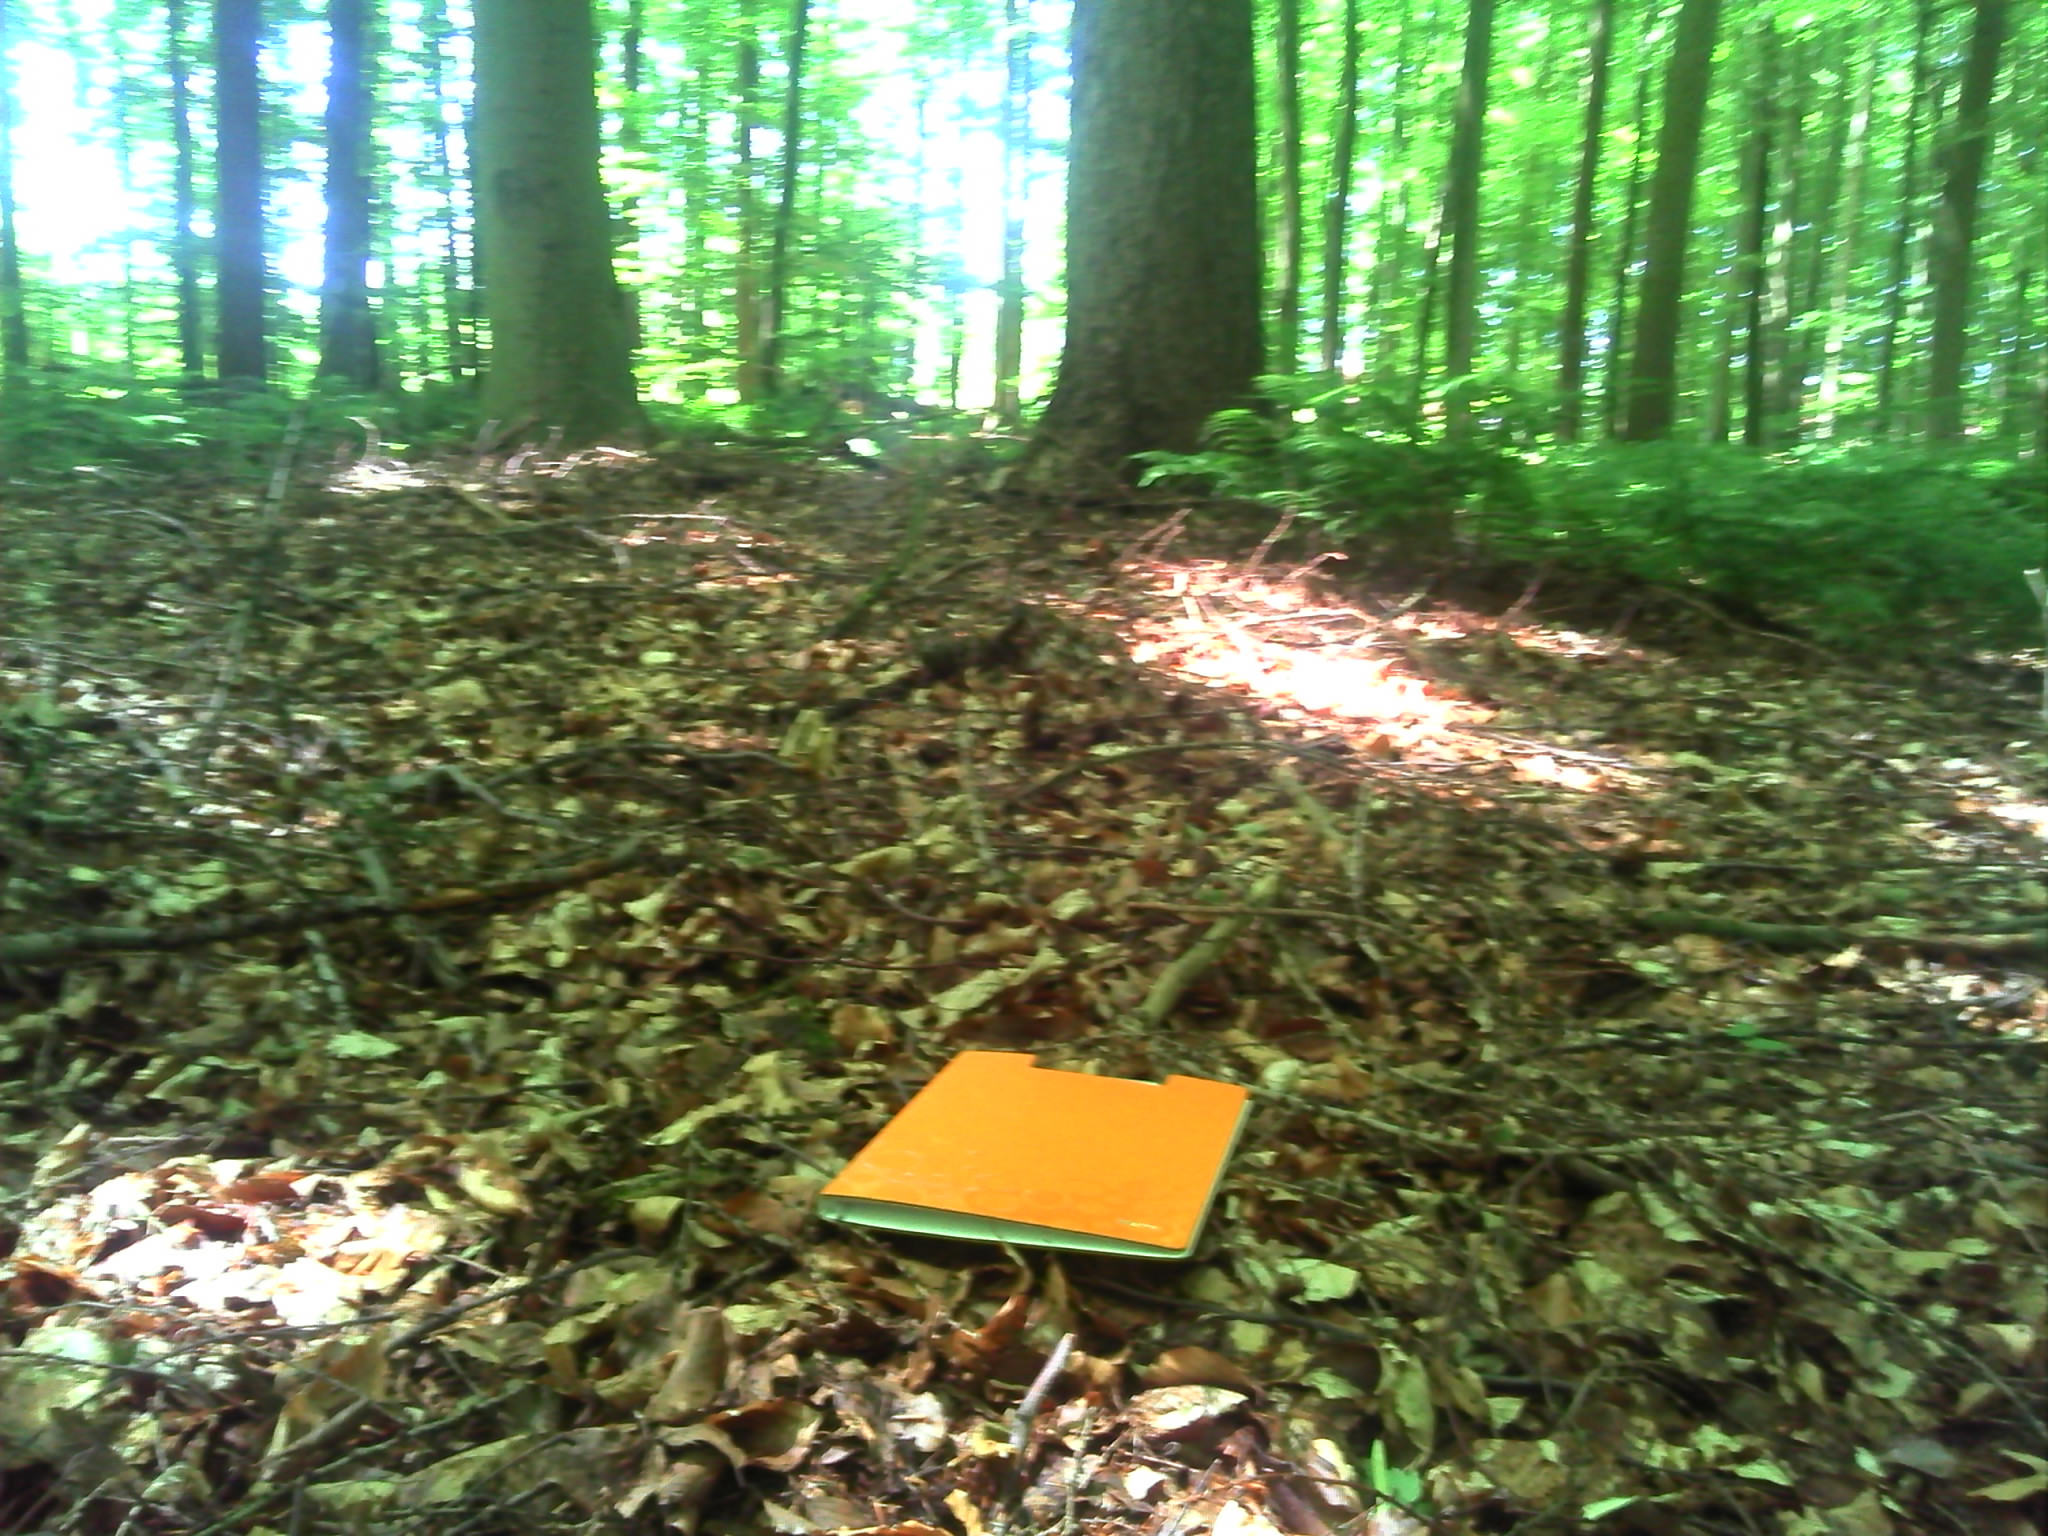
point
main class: Woodland
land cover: Broadleaved woodland
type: beech forest
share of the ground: > 75 %
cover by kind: broadleaved forest trees 80 %, shrubs 10 %, coniferous forest trees 5 %, herbaceous plants 5 %
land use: Forestry
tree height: > 5 m
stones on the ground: < 10 %
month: June
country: BE
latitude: 50.7495
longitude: 4.3970
